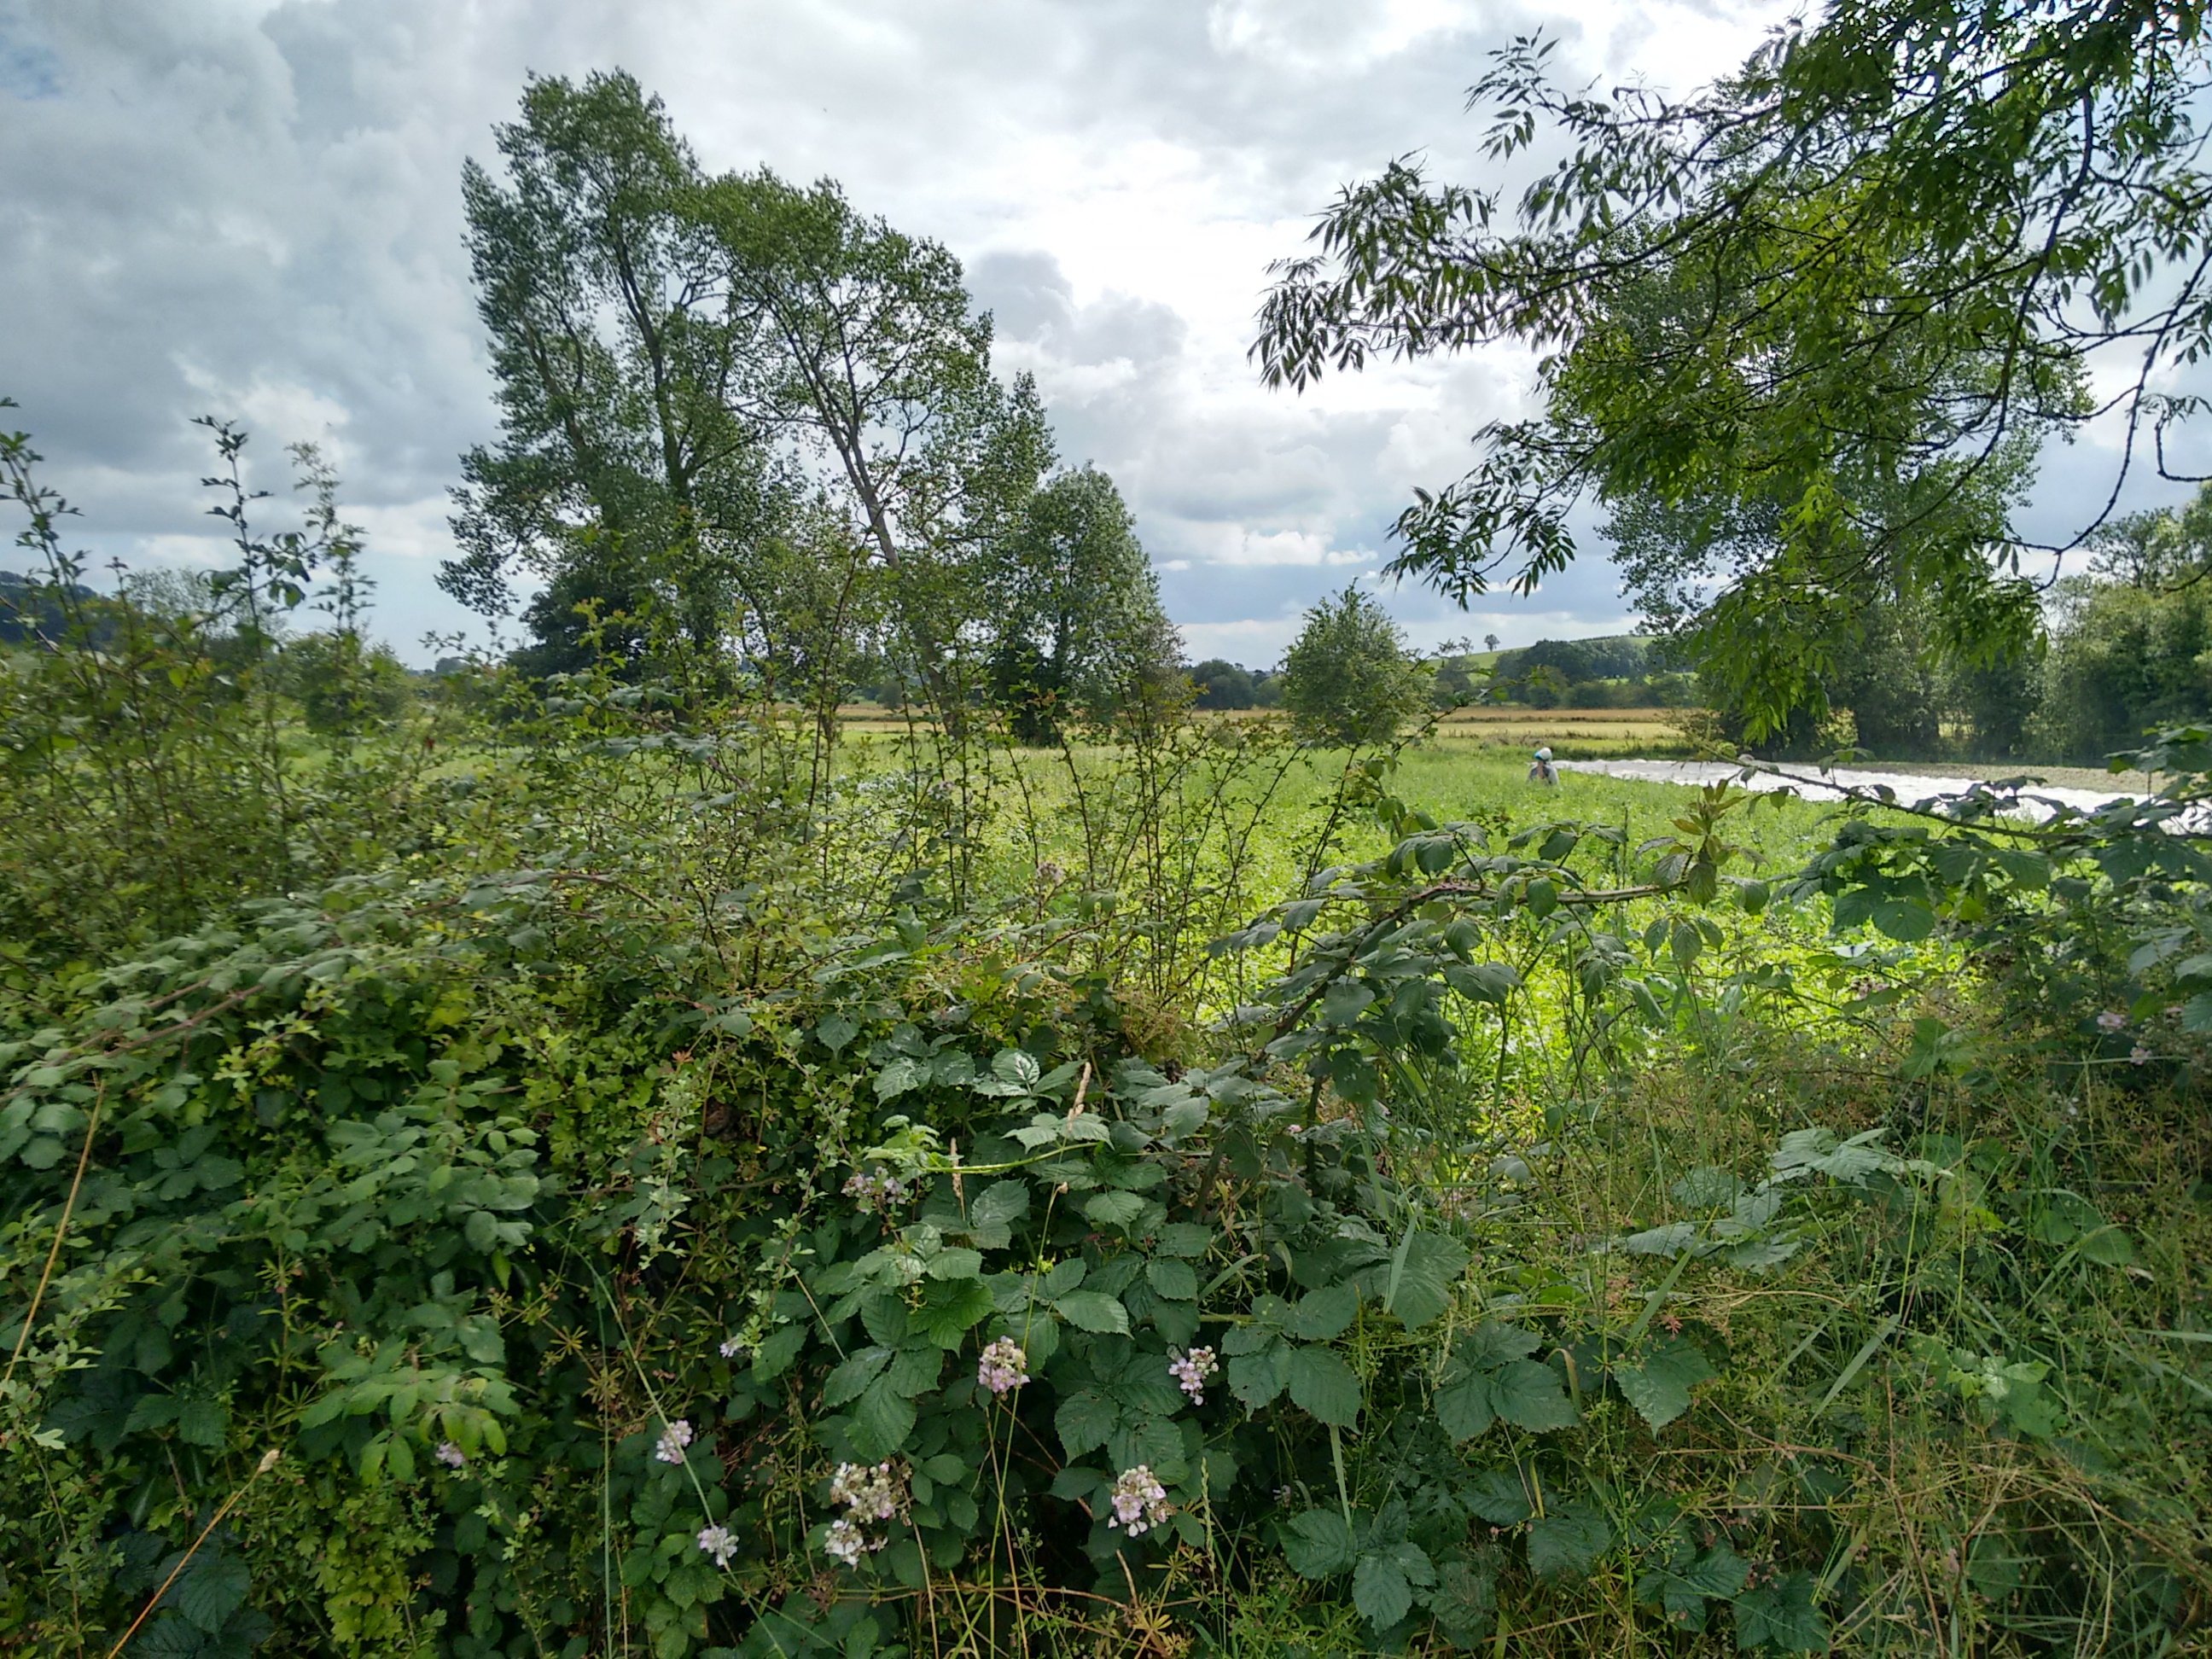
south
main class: Cropland
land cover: Other fresh vegetables
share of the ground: > 75 %
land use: Agriculture (excluding fallow land and kitchen gardens)
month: August
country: GB
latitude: 54.3553
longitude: -6.8931
